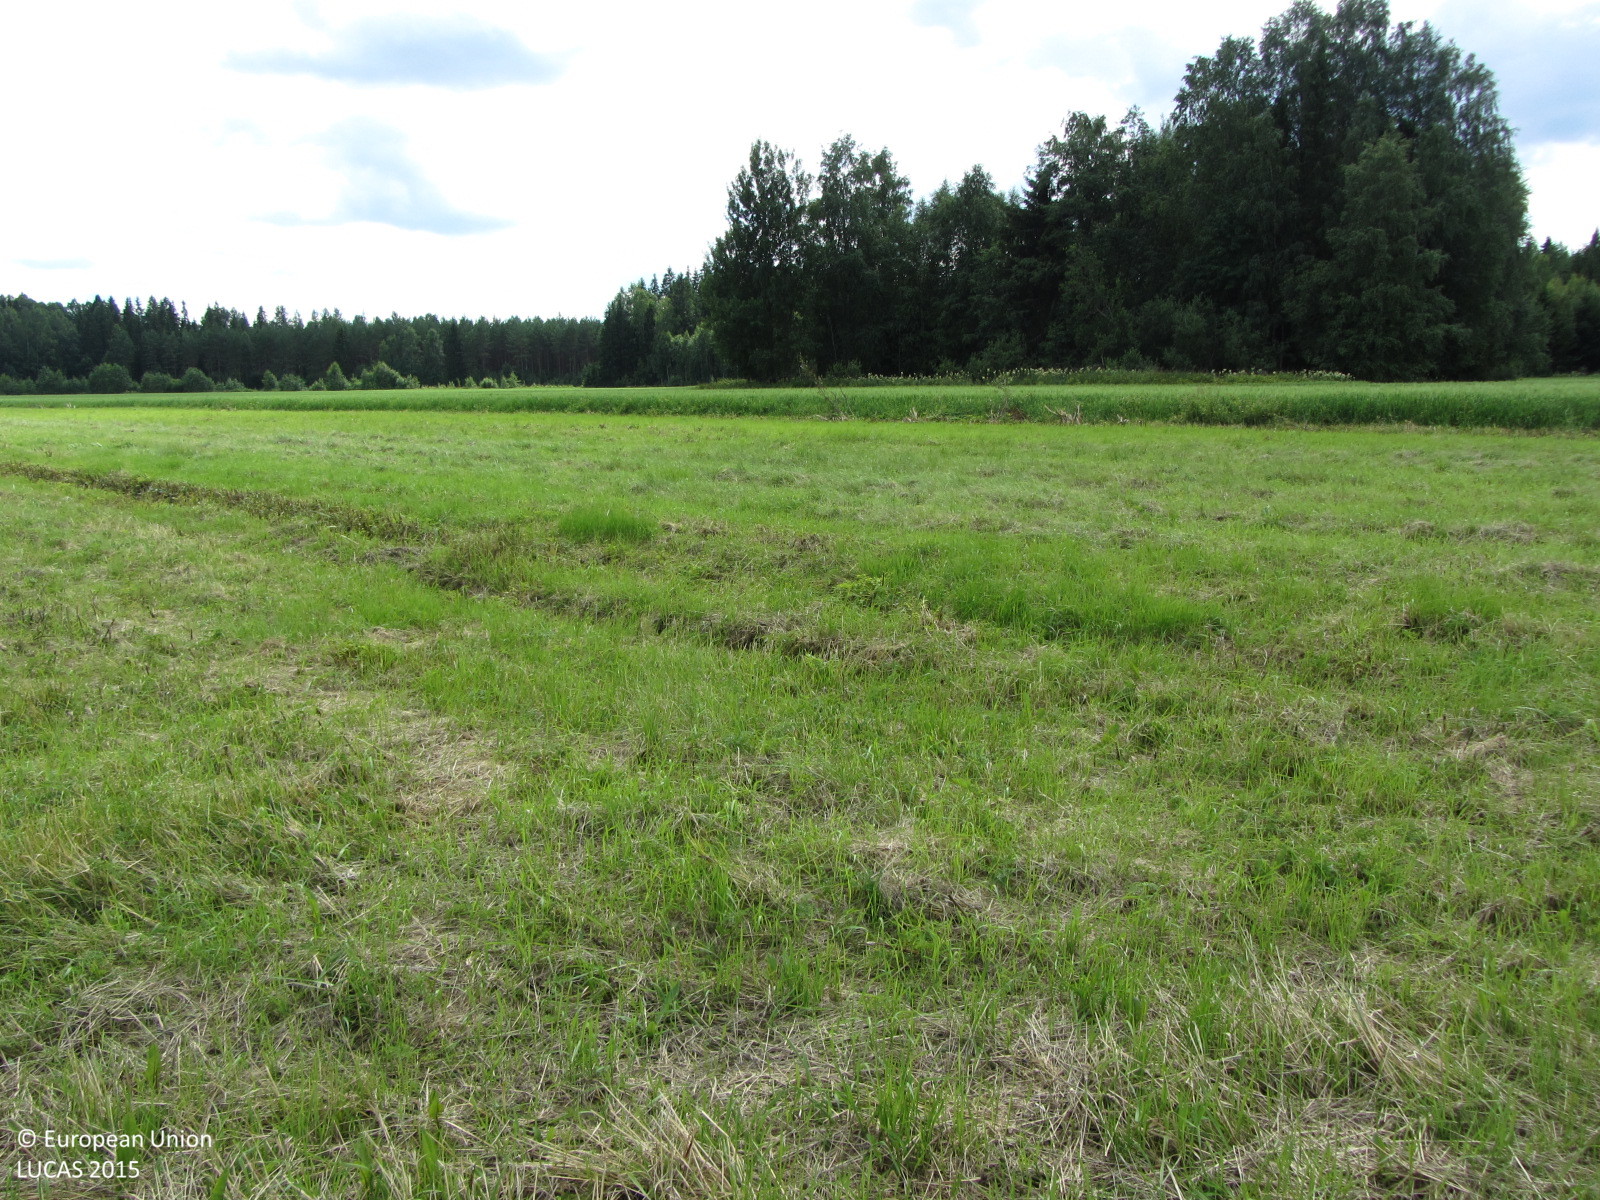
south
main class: Grassland
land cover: Grassland without tree/shrub cover
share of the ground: > 75 %
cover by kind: herbaceous plants 100 %
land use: Agriculture (excluding fallow land and kitchen gardens)
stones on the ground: < 10 %
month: July
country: FI
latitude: 60.7080
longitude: 24.5255
